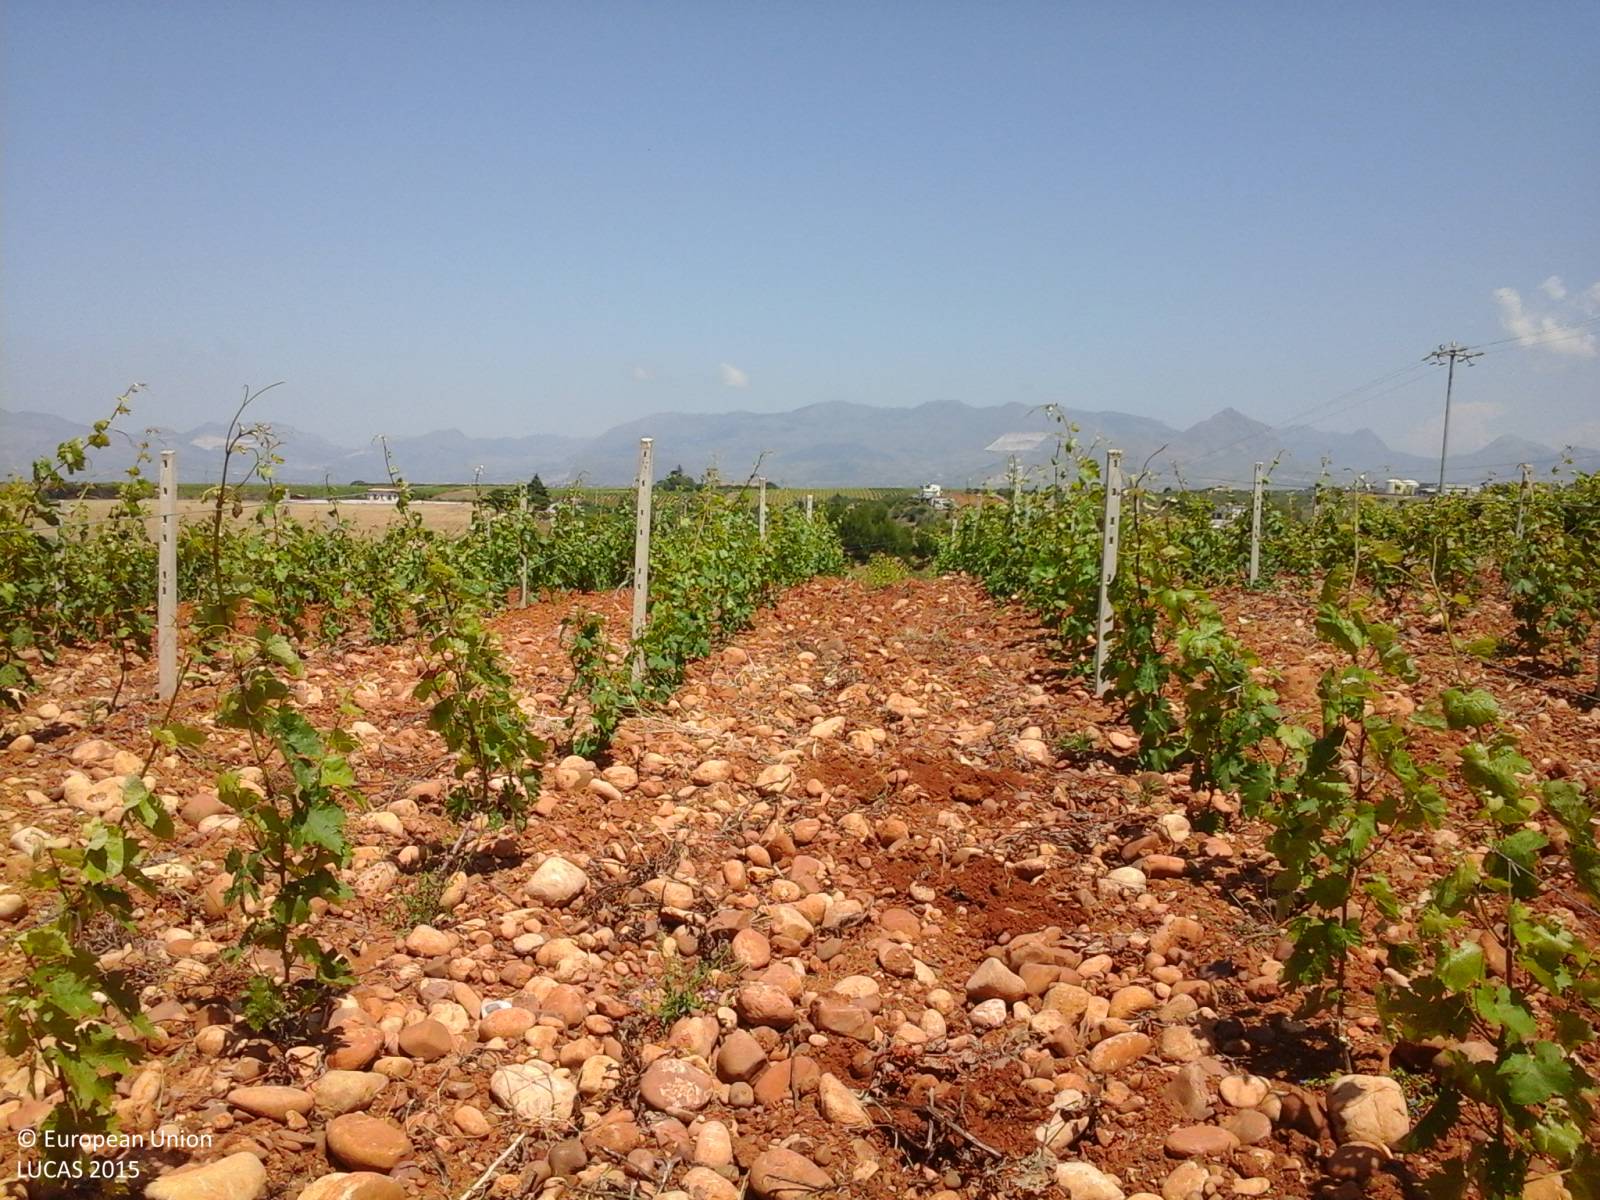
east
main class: Cropland
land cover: Vineyards
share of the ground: 25 - 50 %
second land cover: Other bare soil
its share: > 75 %
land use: Agriculture (excluding fallow land and kitchen gardens)
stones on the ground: > 50 %
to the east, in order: Vineyards; Other bare soil; Electric lines; Vineyards; Electric lines; Vineyards; Electric lines; Tracks; Grassland without tree/shrub cover; Artificial constructions in urban areas
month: June
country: IT
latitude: 37.9910
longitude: 12.9959
